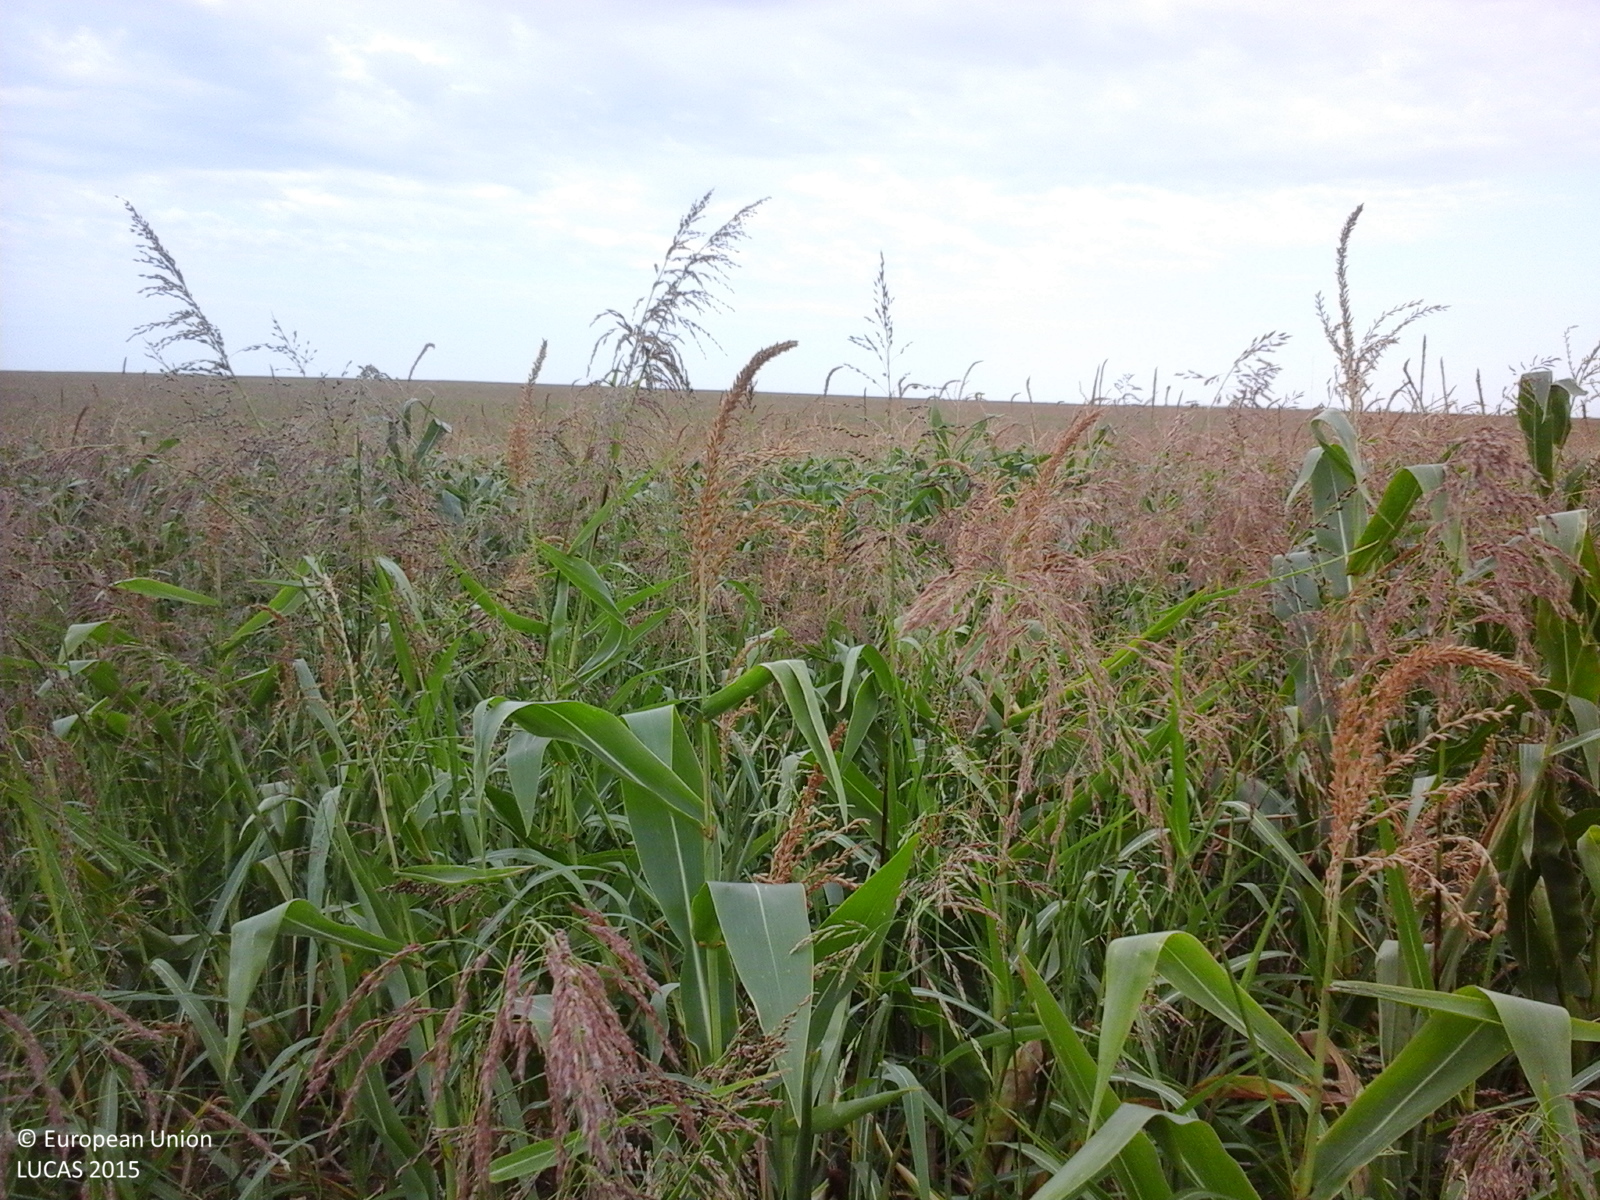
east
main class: Cropland
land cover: Maize
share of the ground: > 75 %
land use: Agriculture (excluding fallow land and kitchen gardens)
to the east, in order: Maize
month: August
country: RO
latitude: 44.2150
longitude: 28.3256
